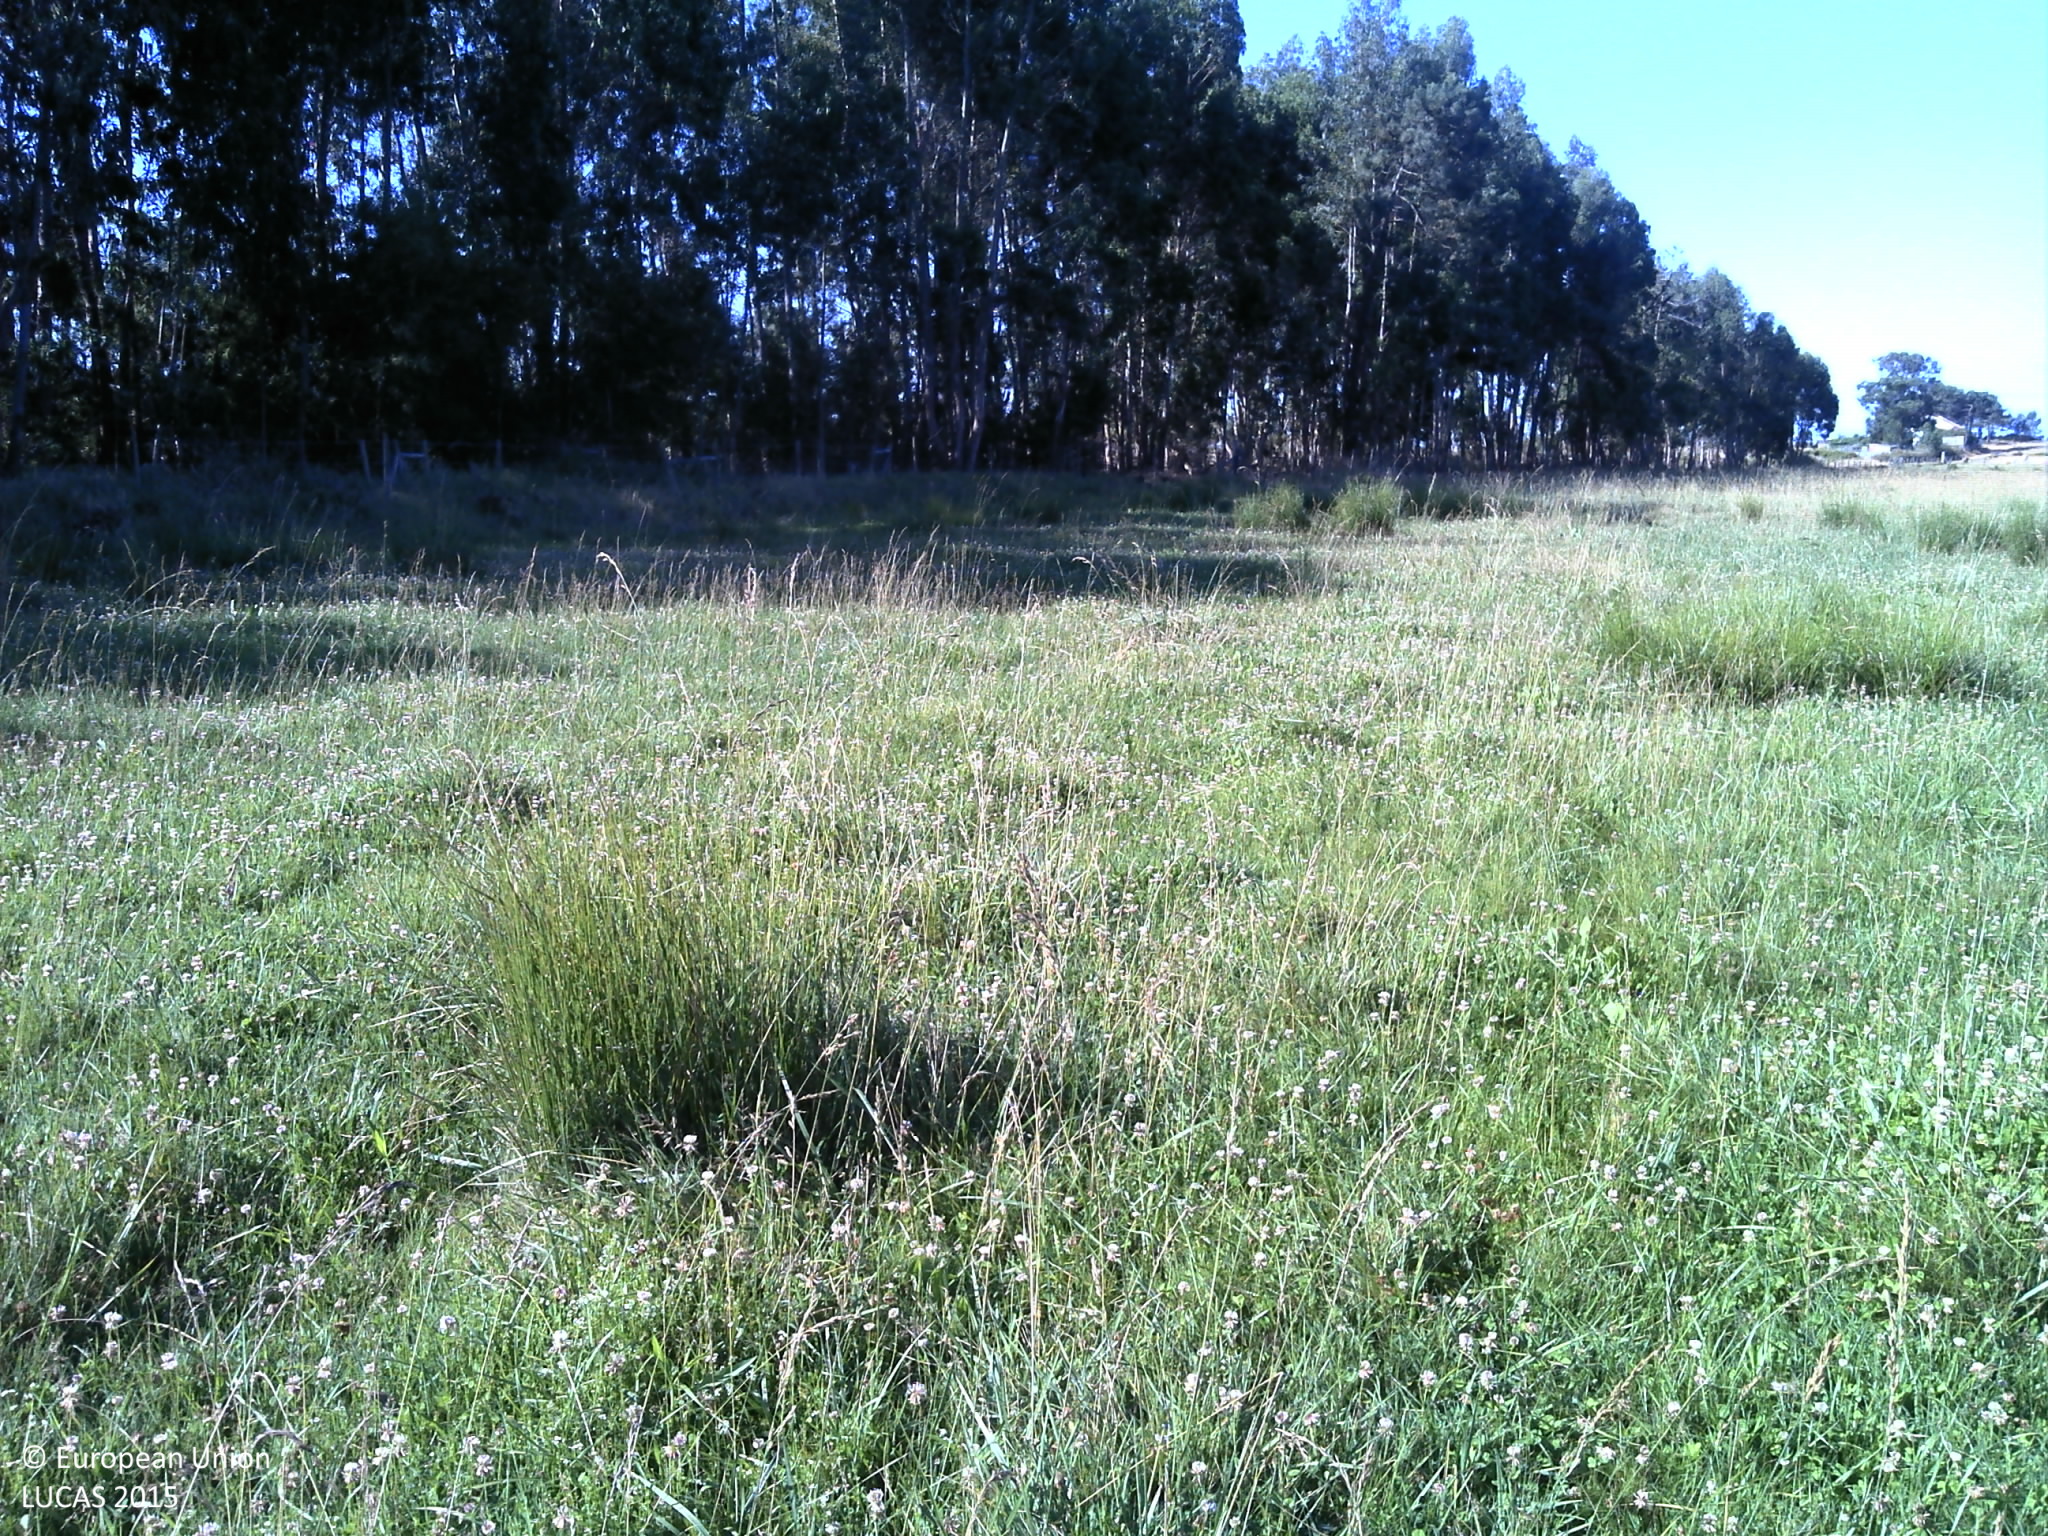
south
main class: Cropland
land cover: Temporary grasslands
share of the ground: > 75 %
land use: Agriculture (excluding fallow land and kitchen gardens)
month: June
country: PT
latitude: 37.4772
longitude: -8.7533
